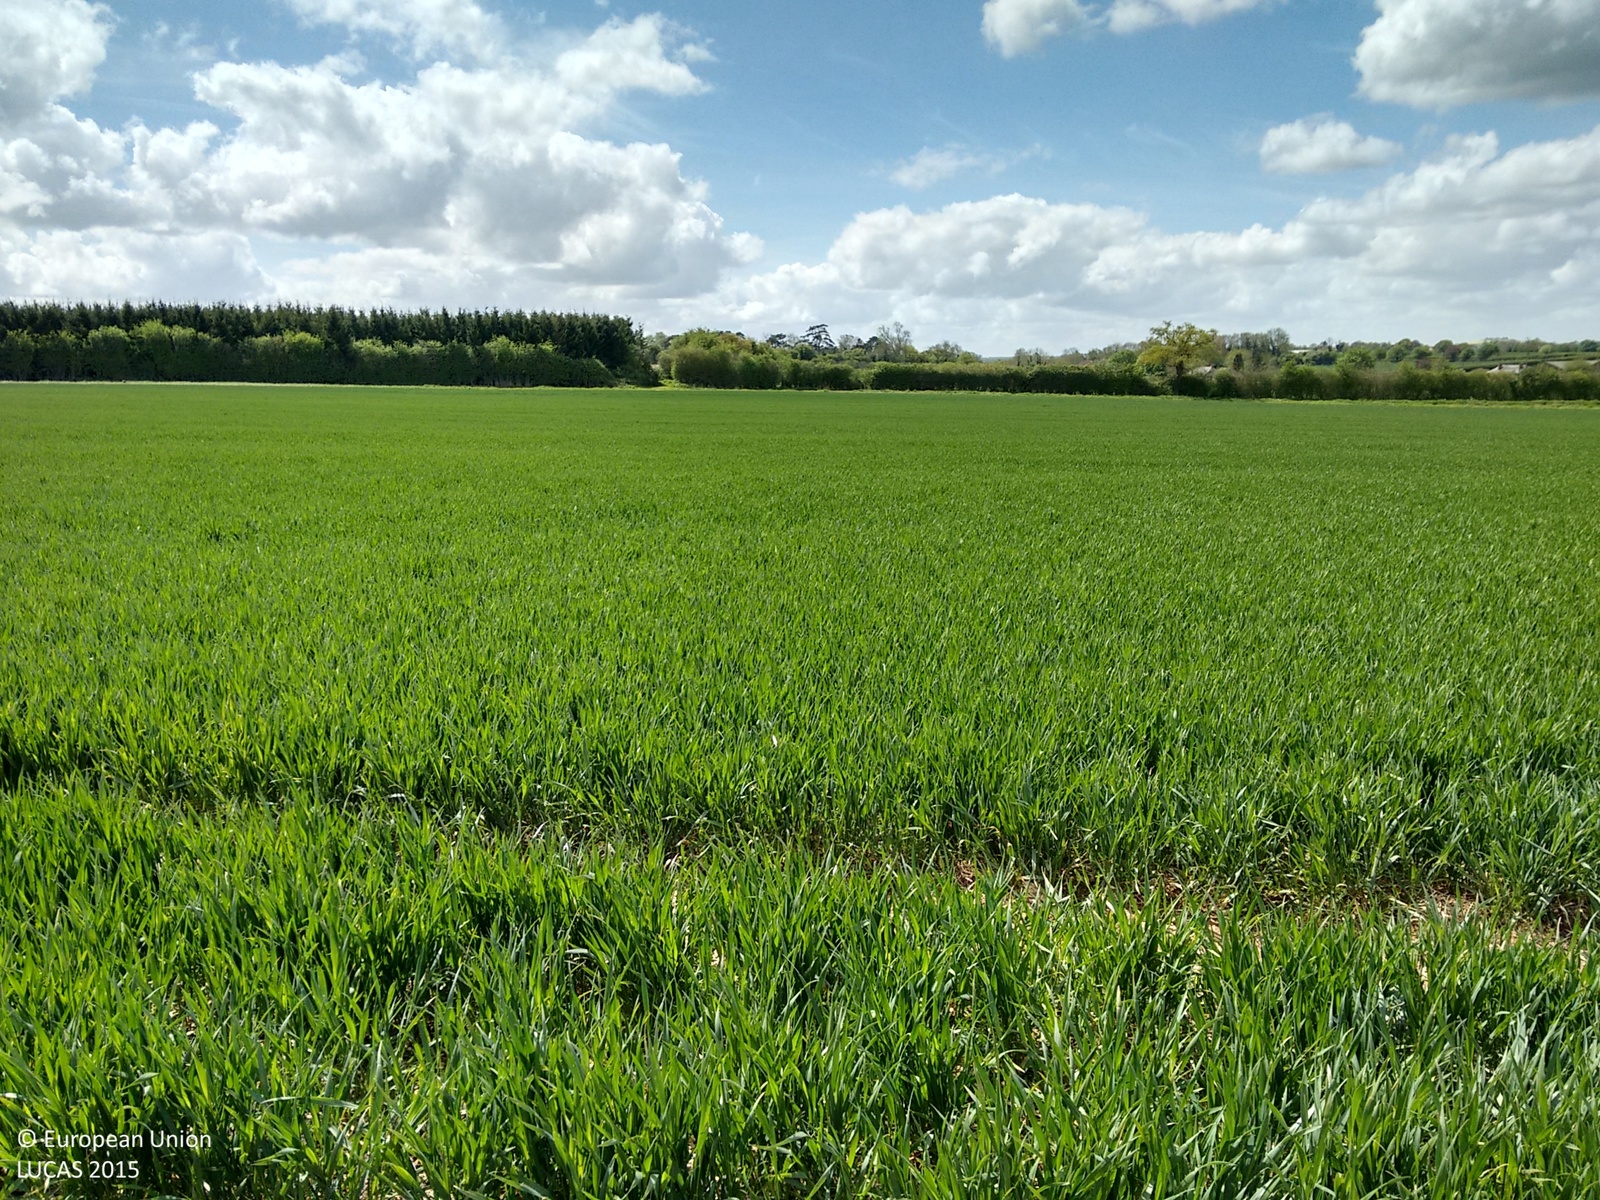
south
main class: Cropland
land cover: Common wheat
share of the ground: > 75 %
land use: Agriculture (excluding fallow land and kitchen gardens)
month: May
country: GB
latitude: 51.2328
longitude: -1.5231
